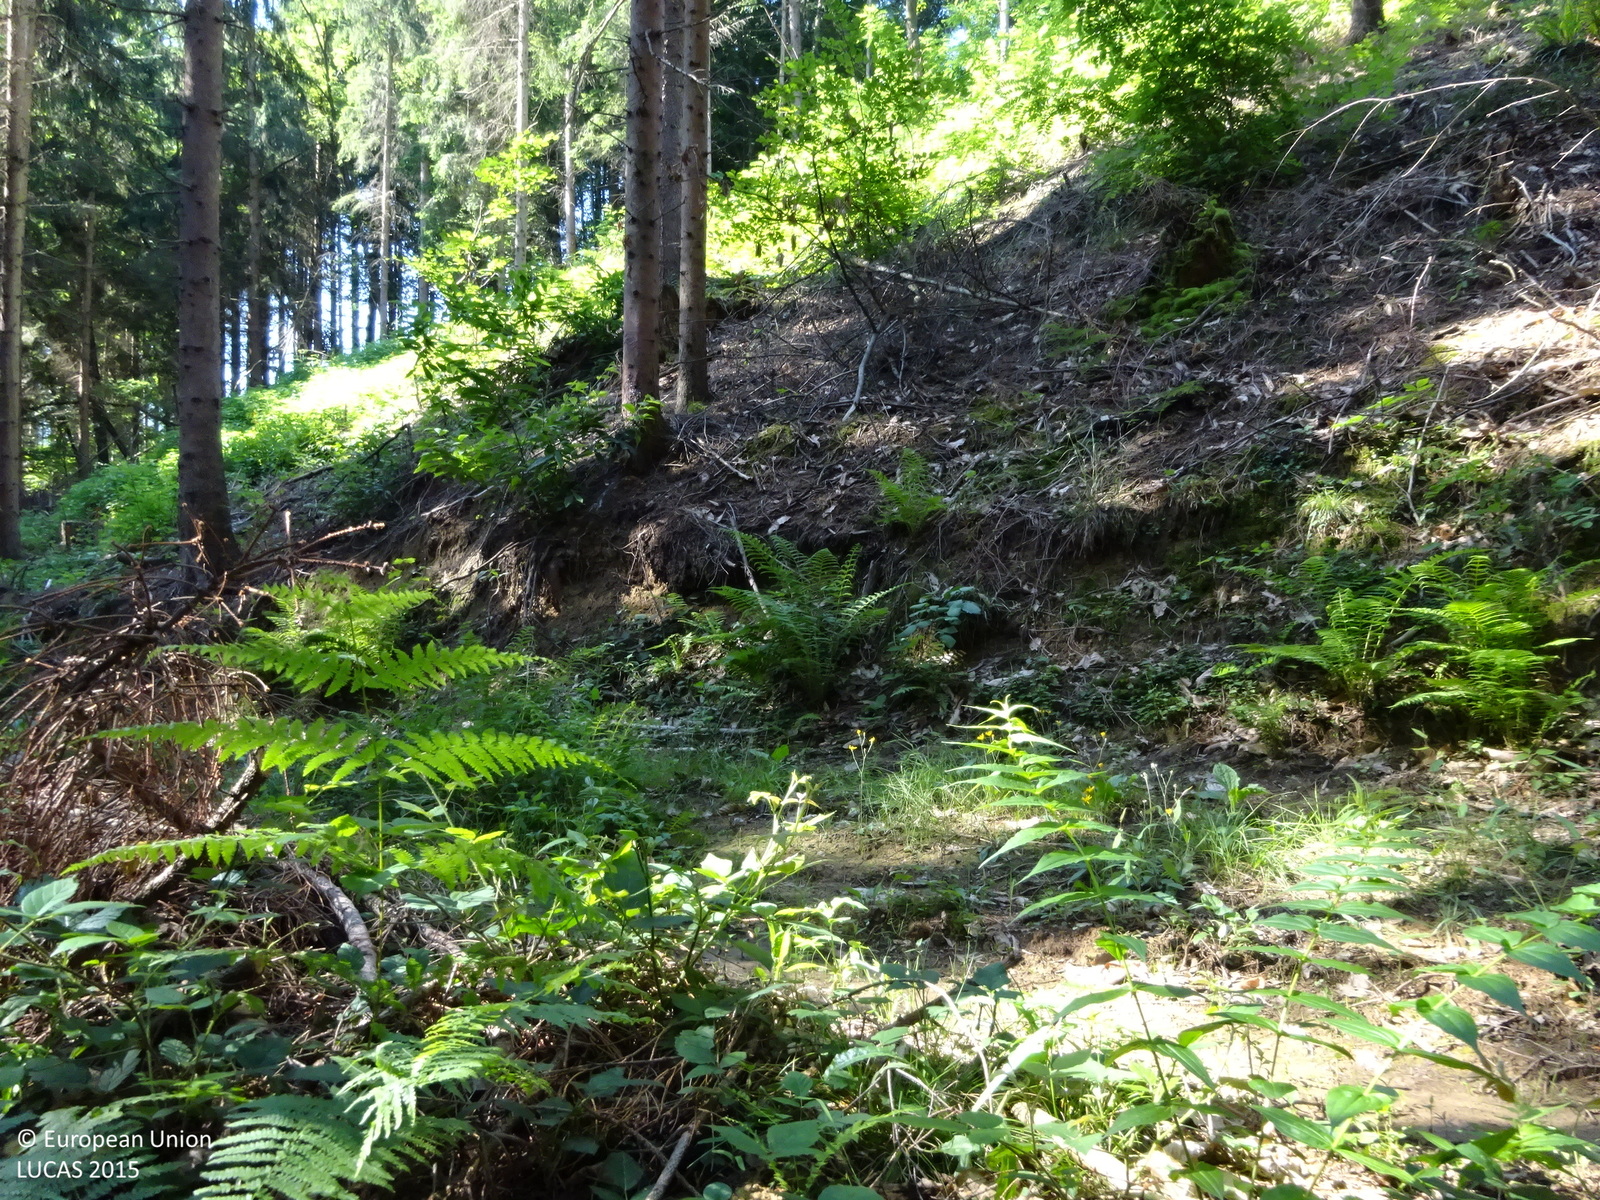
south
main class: Woodland
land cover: Spruce dominated coniferous woodland
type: alpine coniferous forest
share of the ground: > 75 %
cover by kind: coniferous forest trees 95 %, broadleaved forest trees 5 %
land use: Forestry
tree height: > 5 m
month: June
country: AT
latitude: 46.6727
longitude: 15.2665
